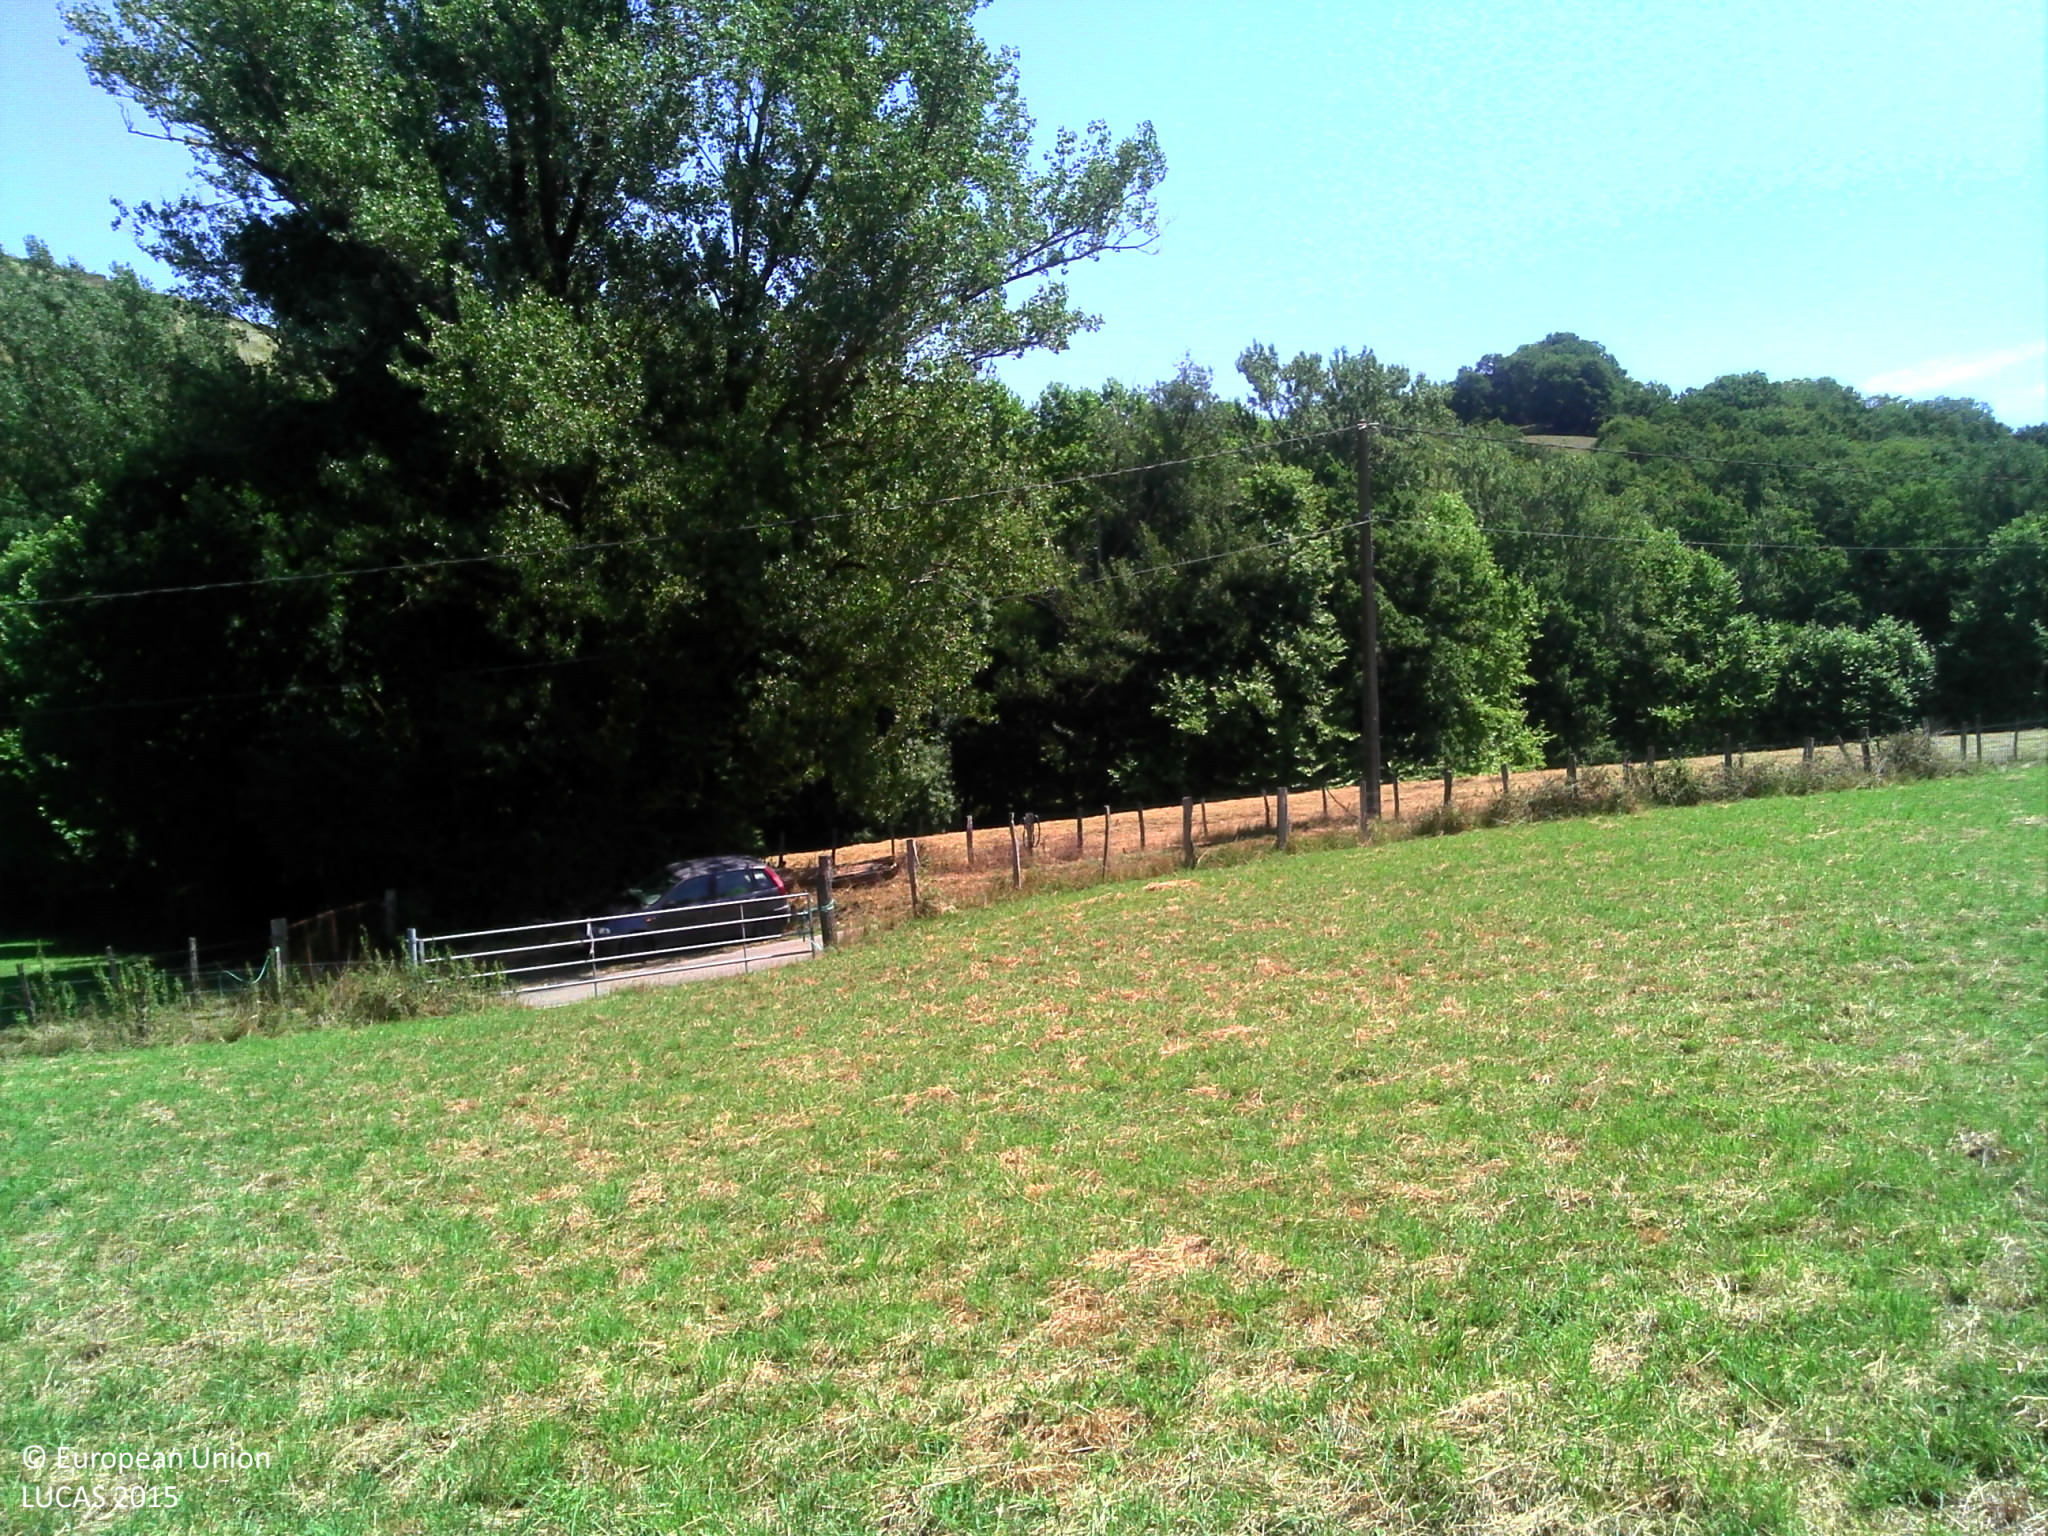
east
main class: Grassland
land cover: Grassland without tree/shrub cover
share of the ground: > 75 %
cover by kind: herbaceous plants 100 %
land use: Agriculture (excluding fallow land and kitchen gardens)
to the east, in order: Grassland without tree/shrub cover; Fences; Electric lines; Grass margins; Paved roads, cycling and walking lanes; Grass margins; Fences; Electric lines; Grassland without tree/shrub cover; Broadleaved woodland; Inland fresh running water; Broadleaved woodland; Fences; Grassland without tree/shrub cover; Tracks; Rivers and streams; Broadleaved woodland; Tracks; Broadleaved woodland
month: August
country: FR
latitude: 43.3470
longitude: -1.1537
